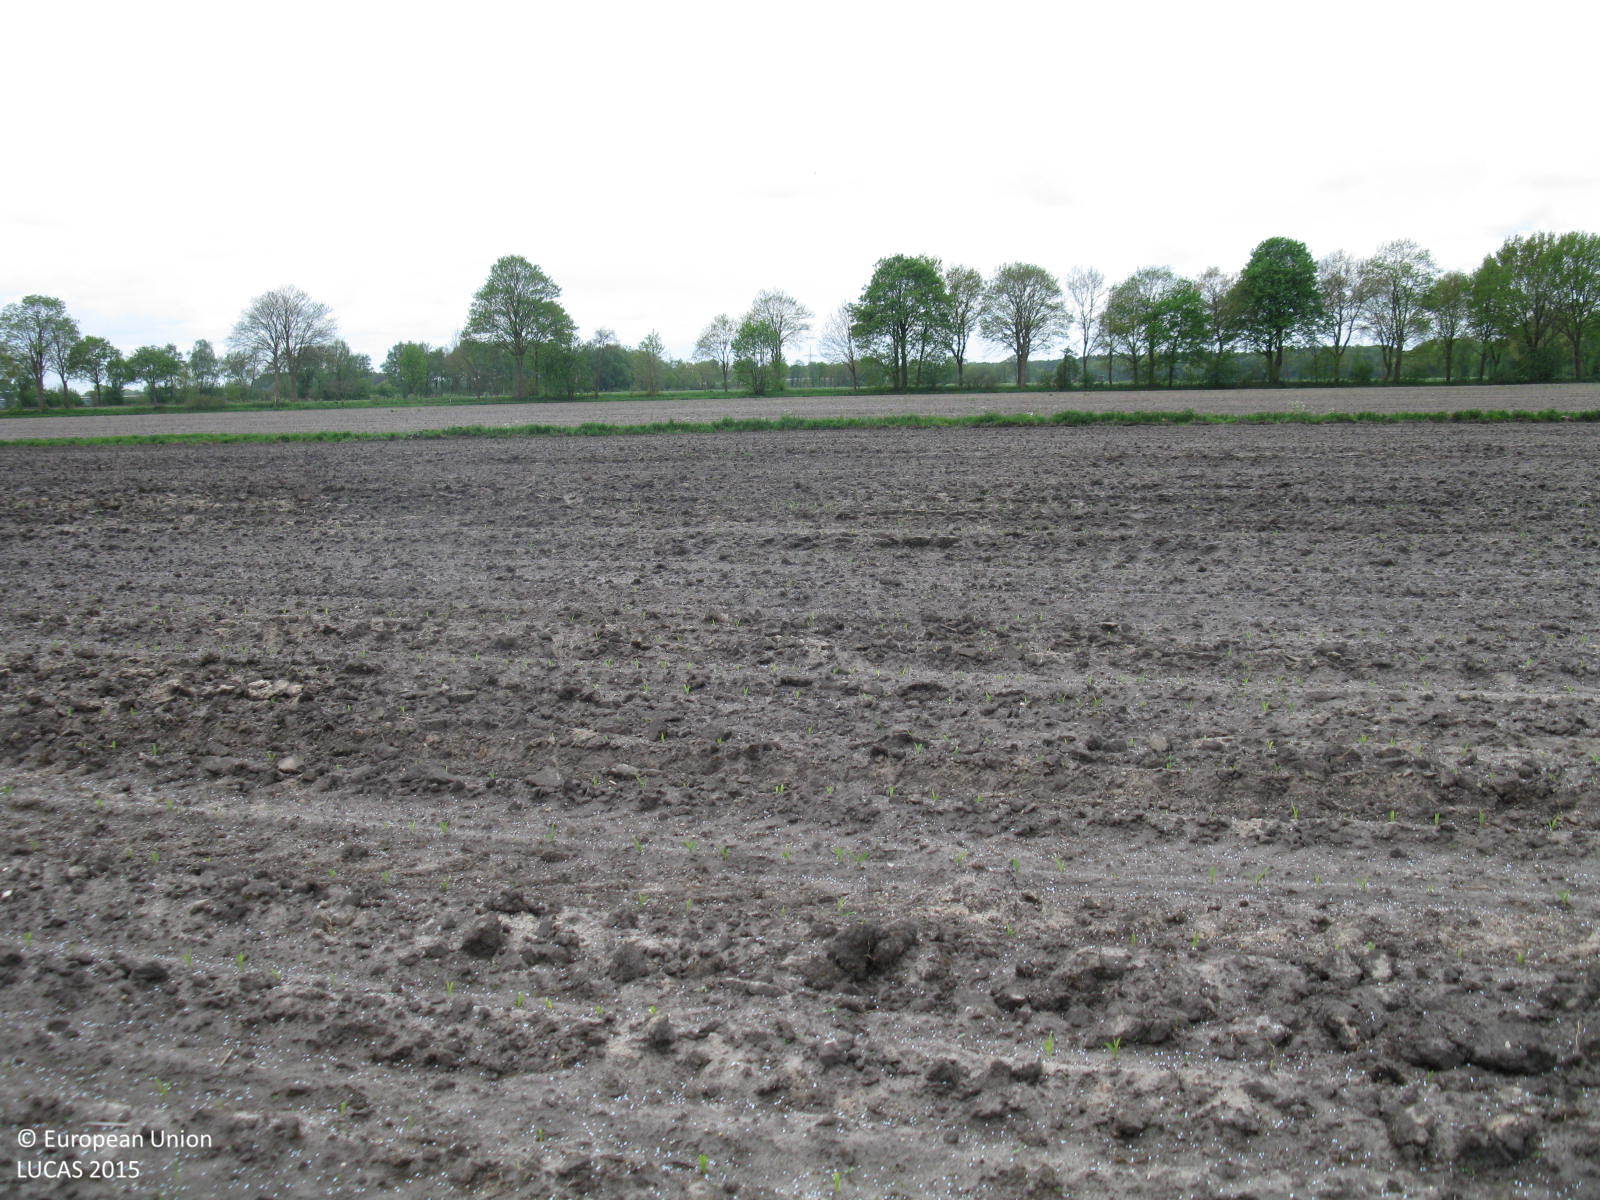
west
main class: Cropland
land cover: Maize
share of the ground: < 10 %
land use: Agriculture (excluding fallow land and kitchen gardens)
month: May
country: DE
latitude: 52.8520
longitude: 7.3720
